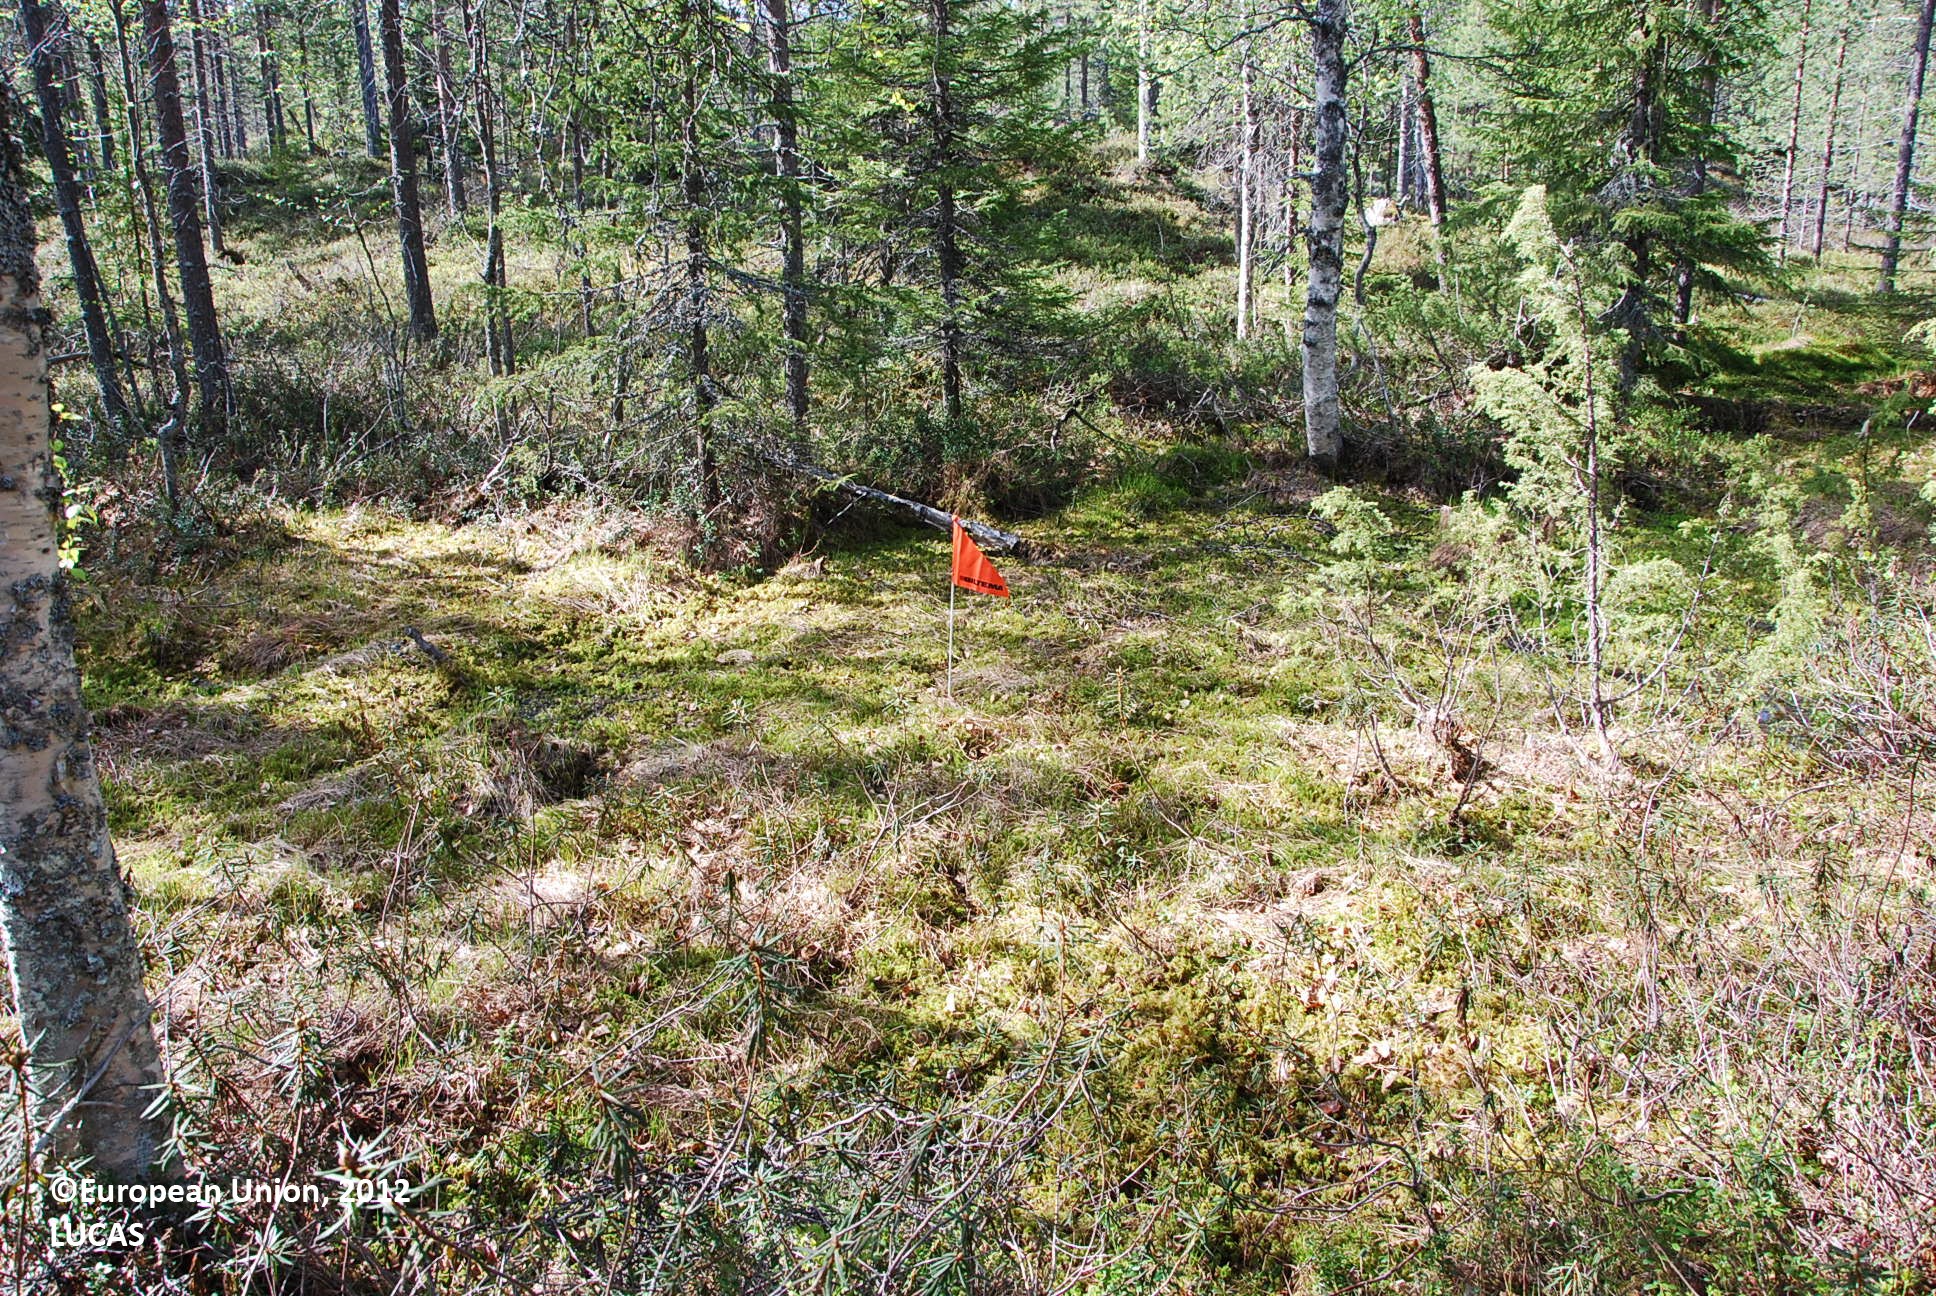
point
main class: Woodland
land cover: Other mixed woodland
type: boreal forest
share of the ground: > 75 %
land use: Forestry
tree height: > 5 m
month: June
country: FI
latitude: 66.3406
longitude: 27.8357
